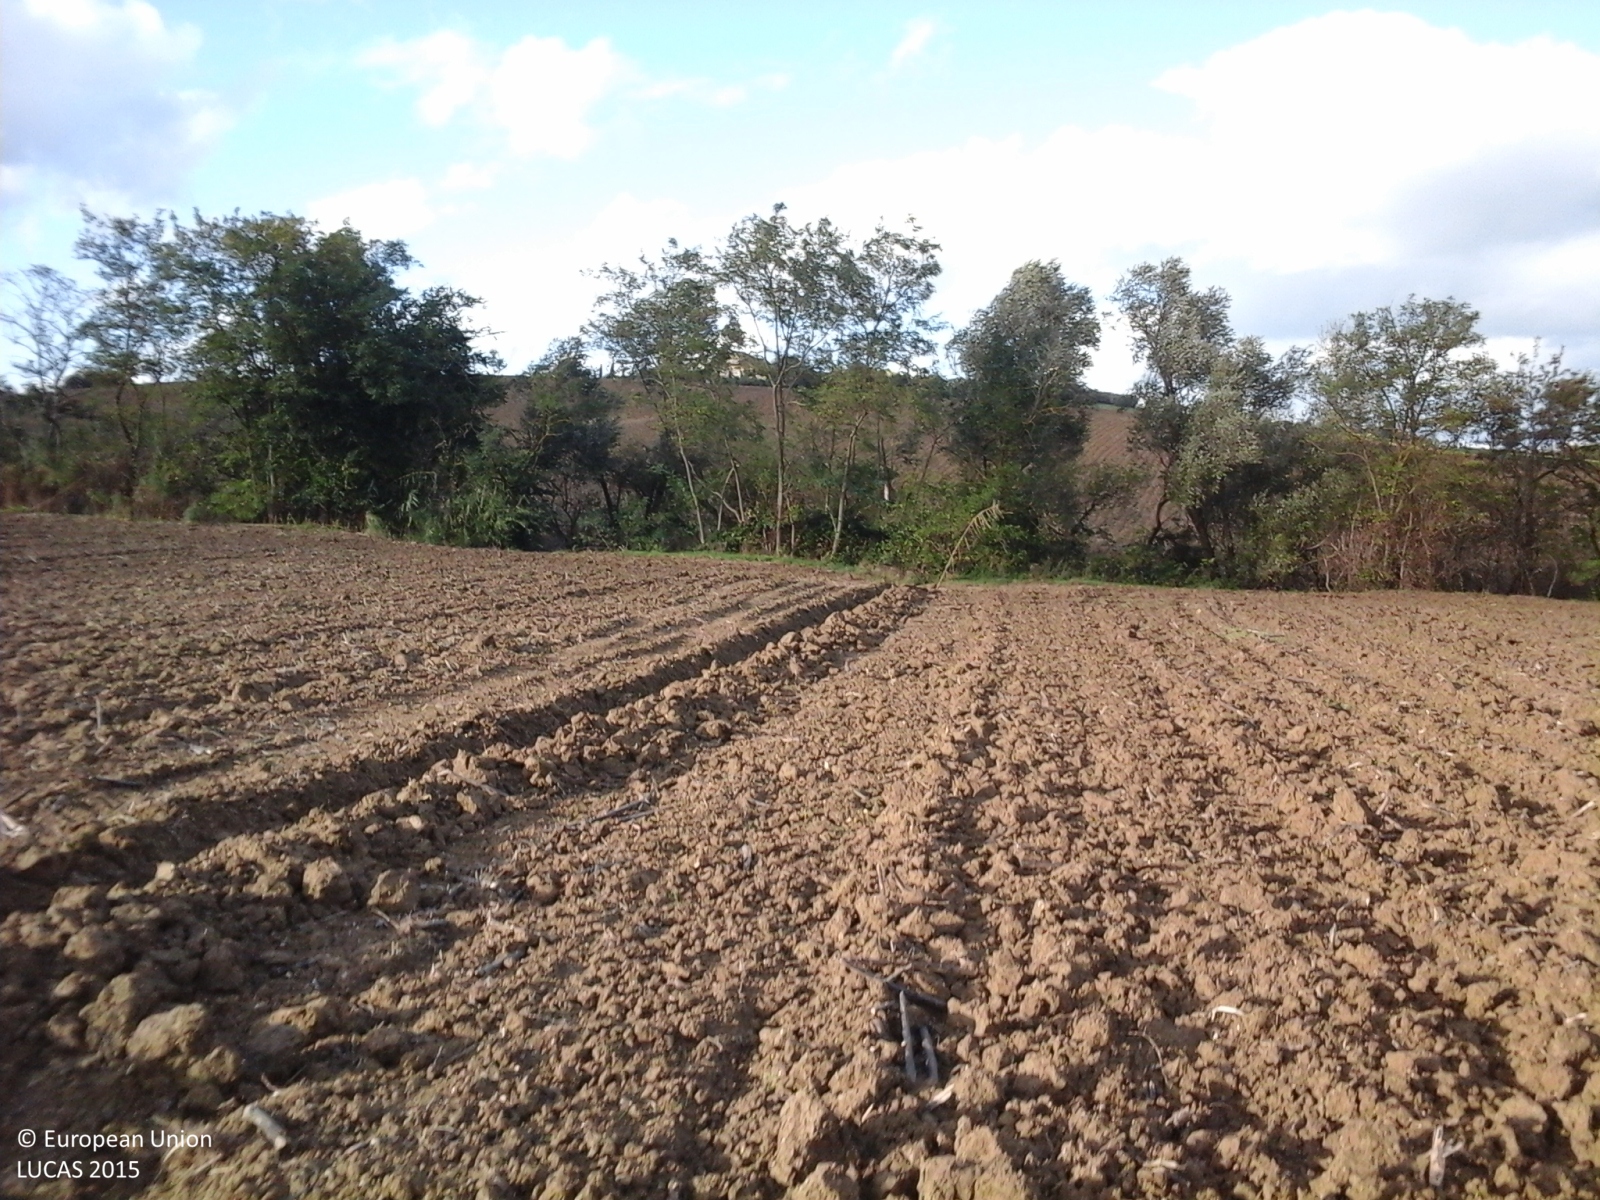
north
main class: Cropland
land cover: Sunflower
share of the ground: < 10 %
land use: Agriculture (excluding fallow land and kitchen gardens)
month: October
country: IT
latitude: 43.6677
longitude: 13.2540
